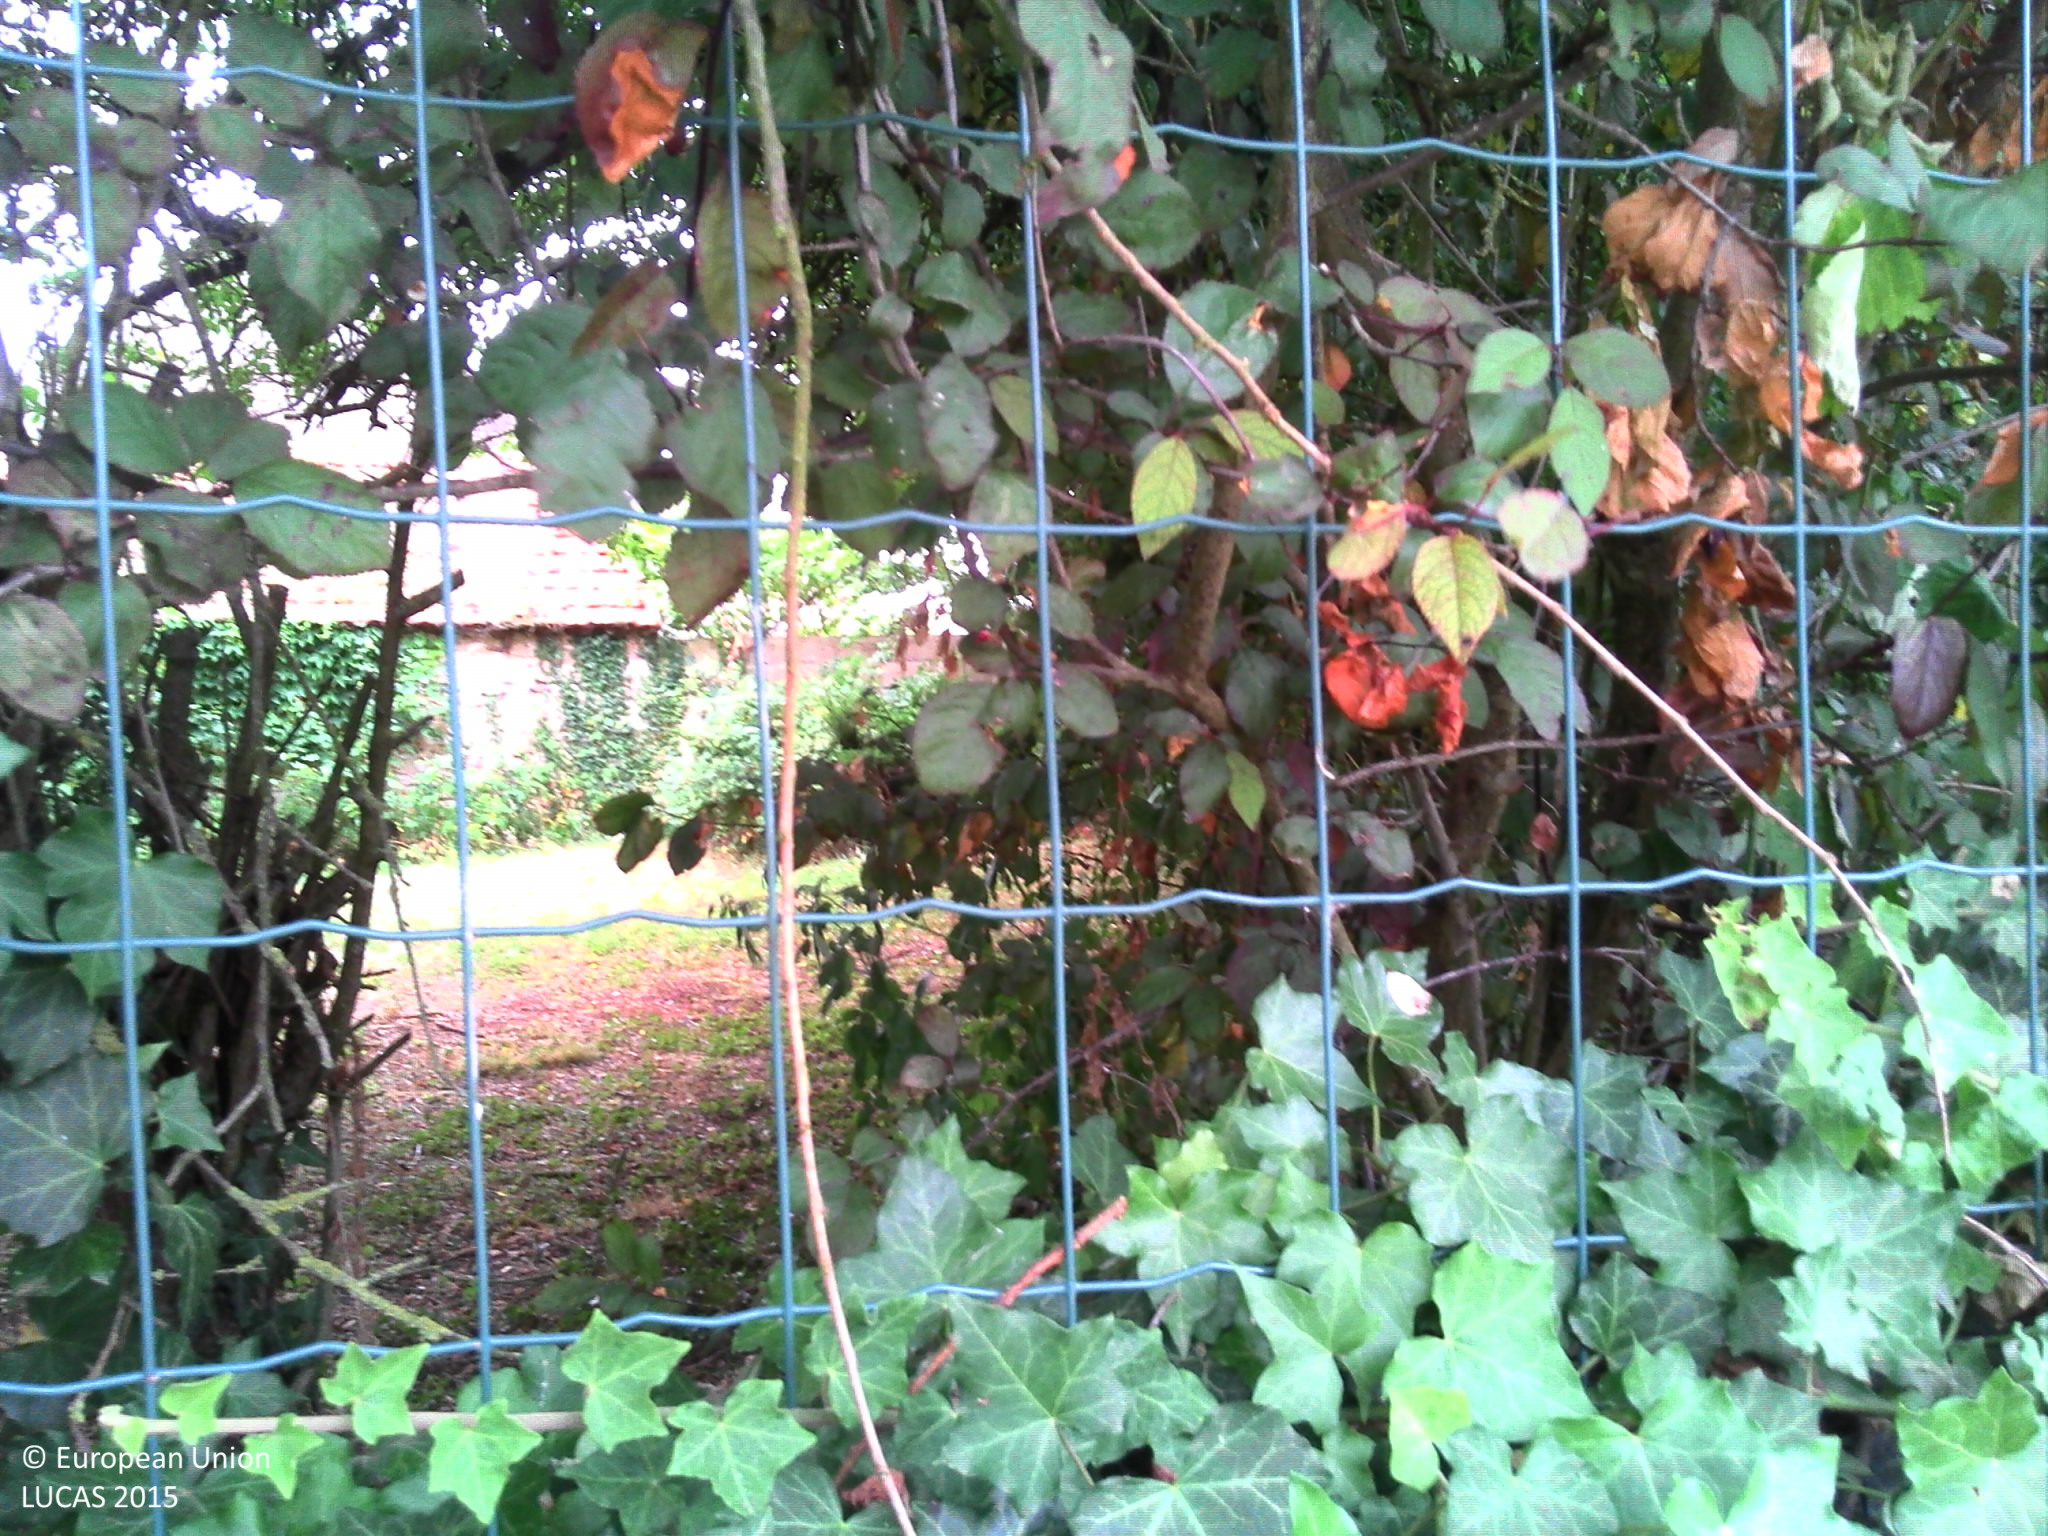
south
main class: Woodland
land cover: Broadleaved woodland
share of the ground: > 75 %
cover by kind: broadleaved forest trees 100 %
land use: Residential
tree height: > 5 m
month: July
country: FR
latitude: 48.0934
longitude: 2.7545
